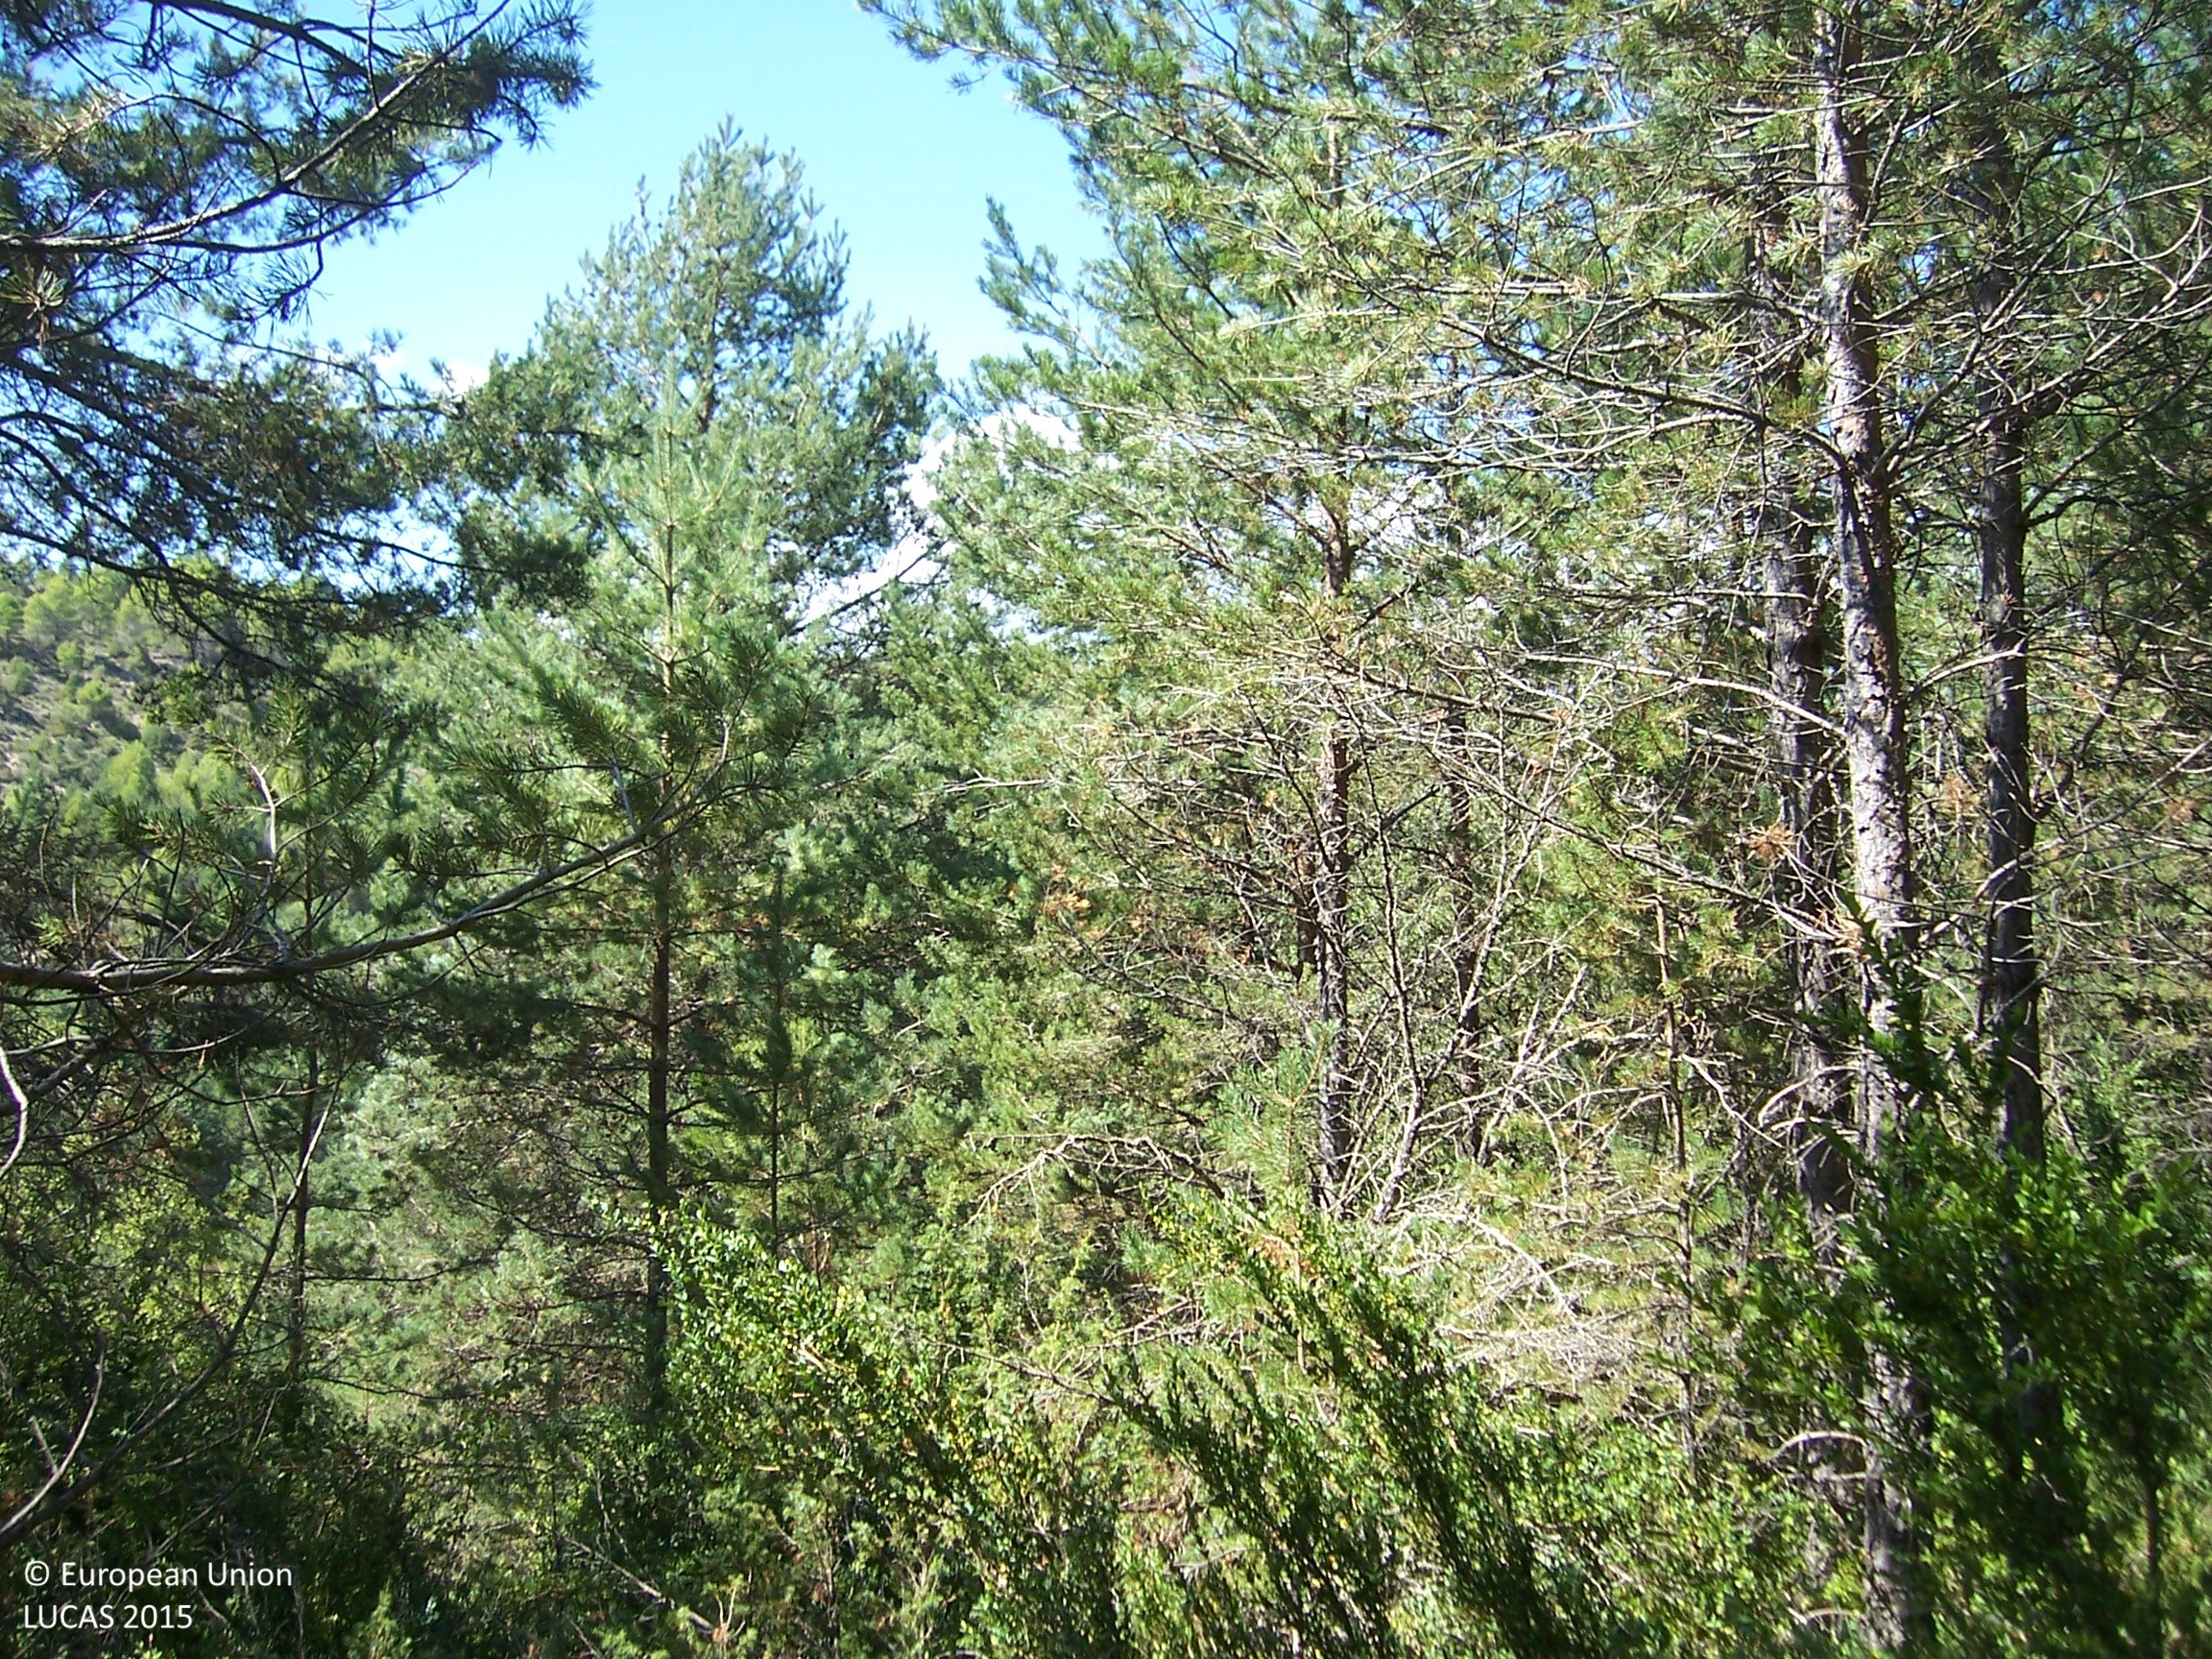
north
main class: Woodland
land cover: Pine dominated coniferous woodland
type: coniferous forest of the mediterranean region
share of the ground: > 75 %
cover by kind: coniferous forest trees 95 %, shrubs 5 %
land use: Forestry
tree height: > 5 m
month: August
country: ES
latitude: 42.3336
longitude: 0.3078
